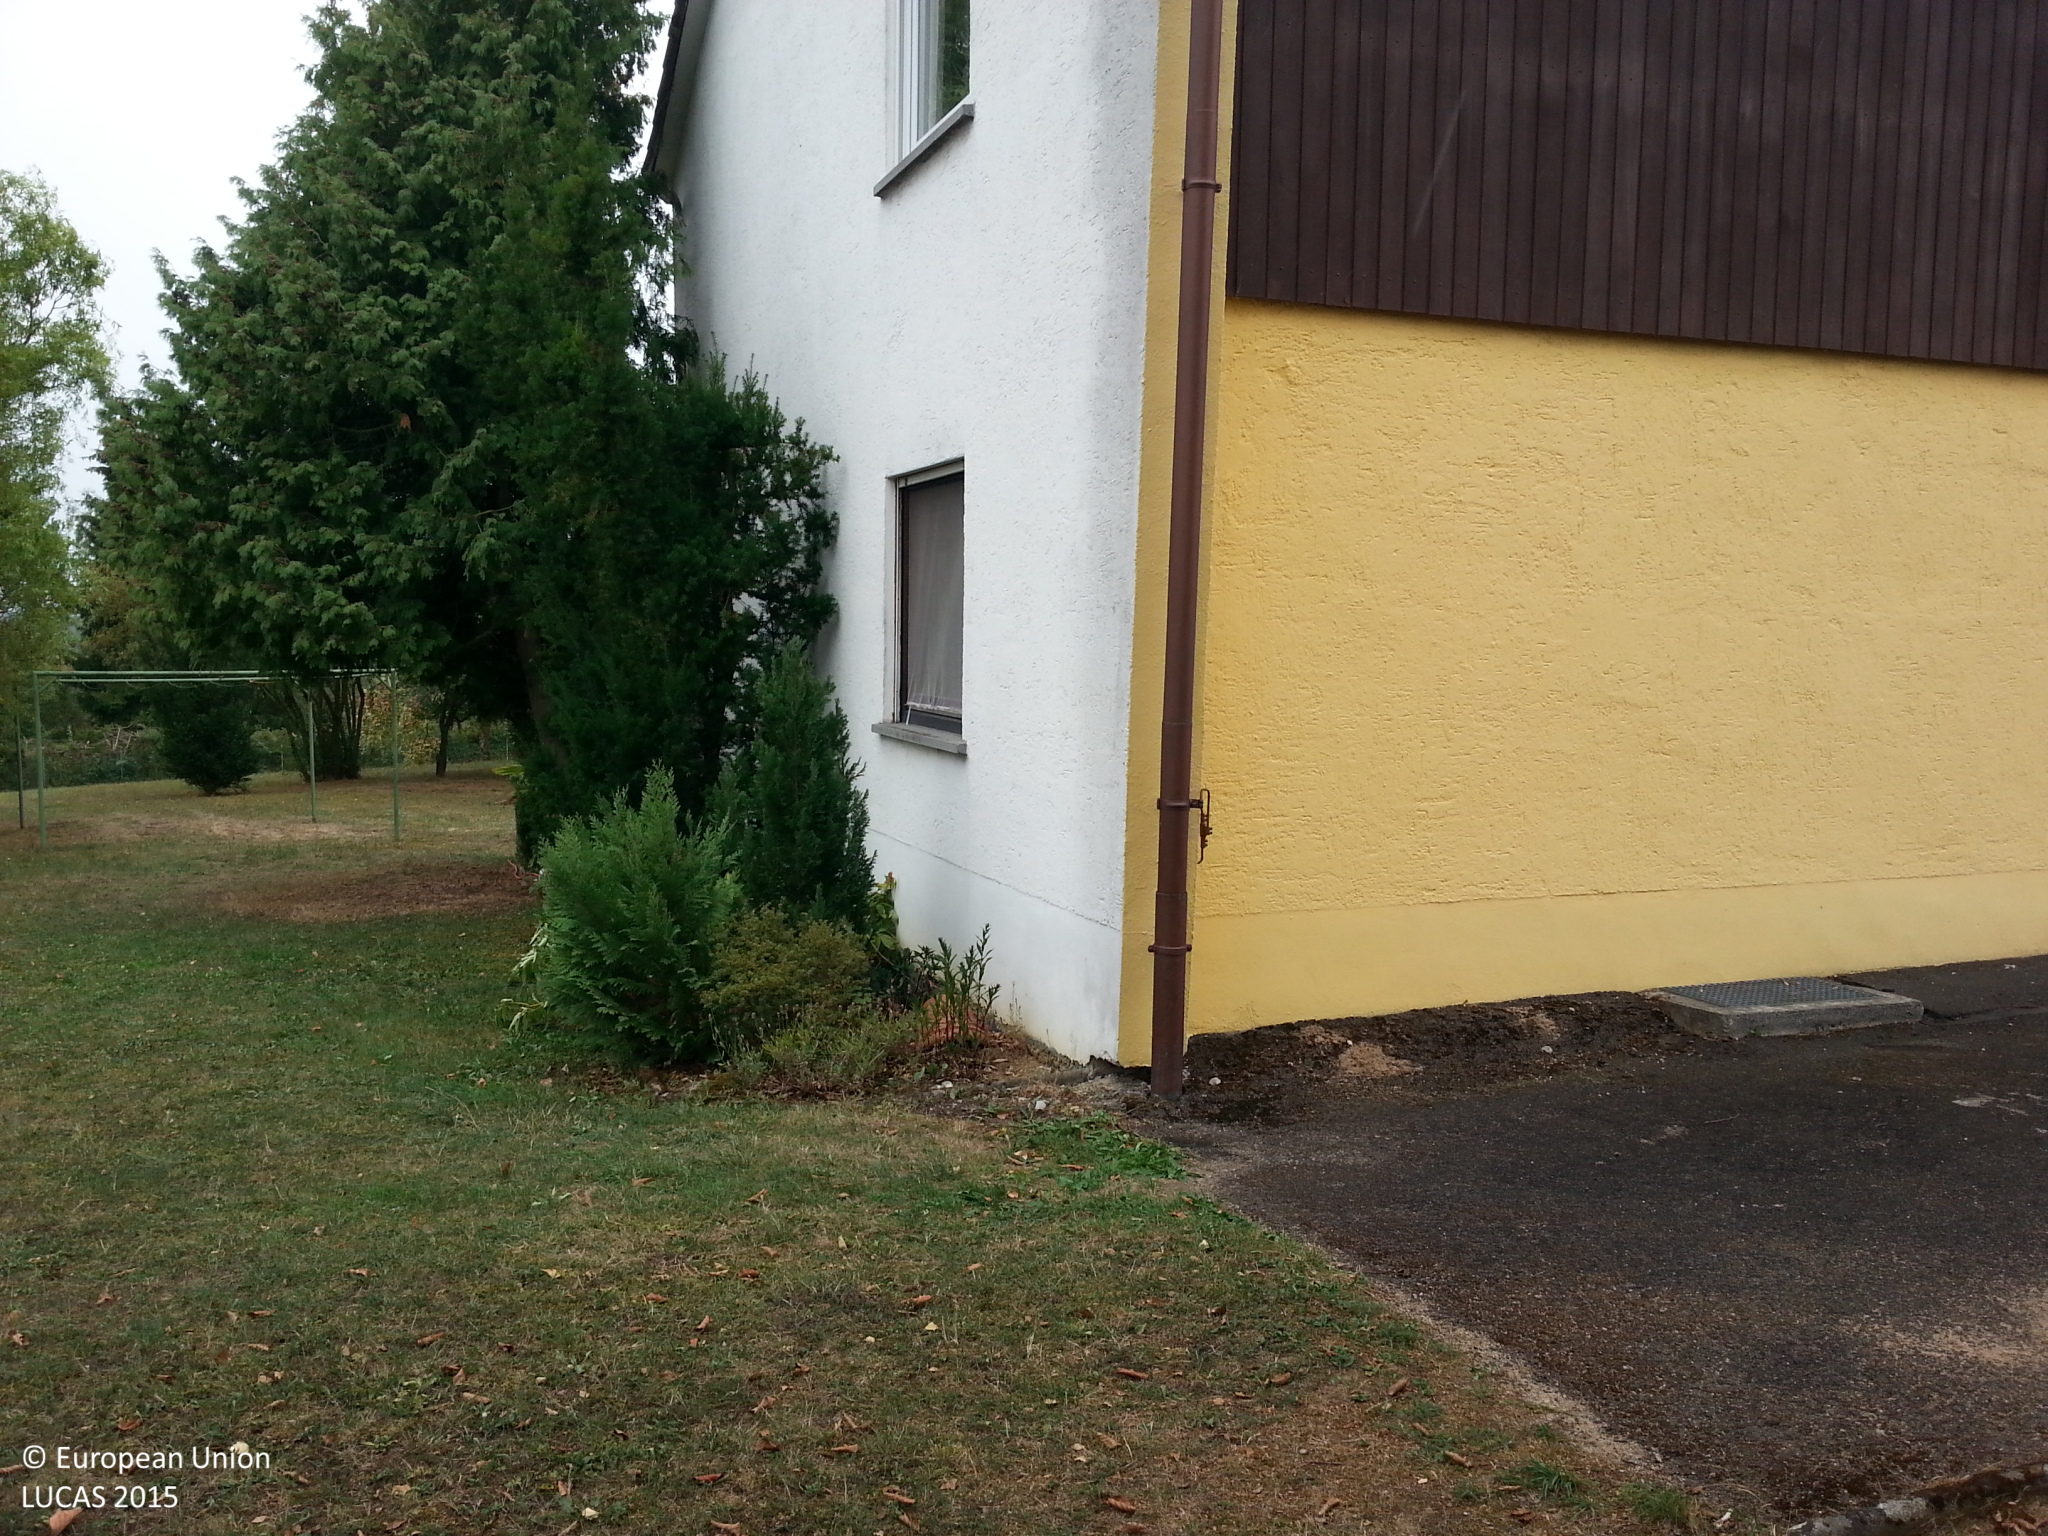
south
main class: Woodland
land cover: Broadleaved woodland
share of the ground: 50 - 75 %
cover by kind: broadleaved forest trees 70 %, herbaceous plants 30 %
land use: Residential
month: September
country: DE
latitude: 49.2490
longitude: 9.9313
